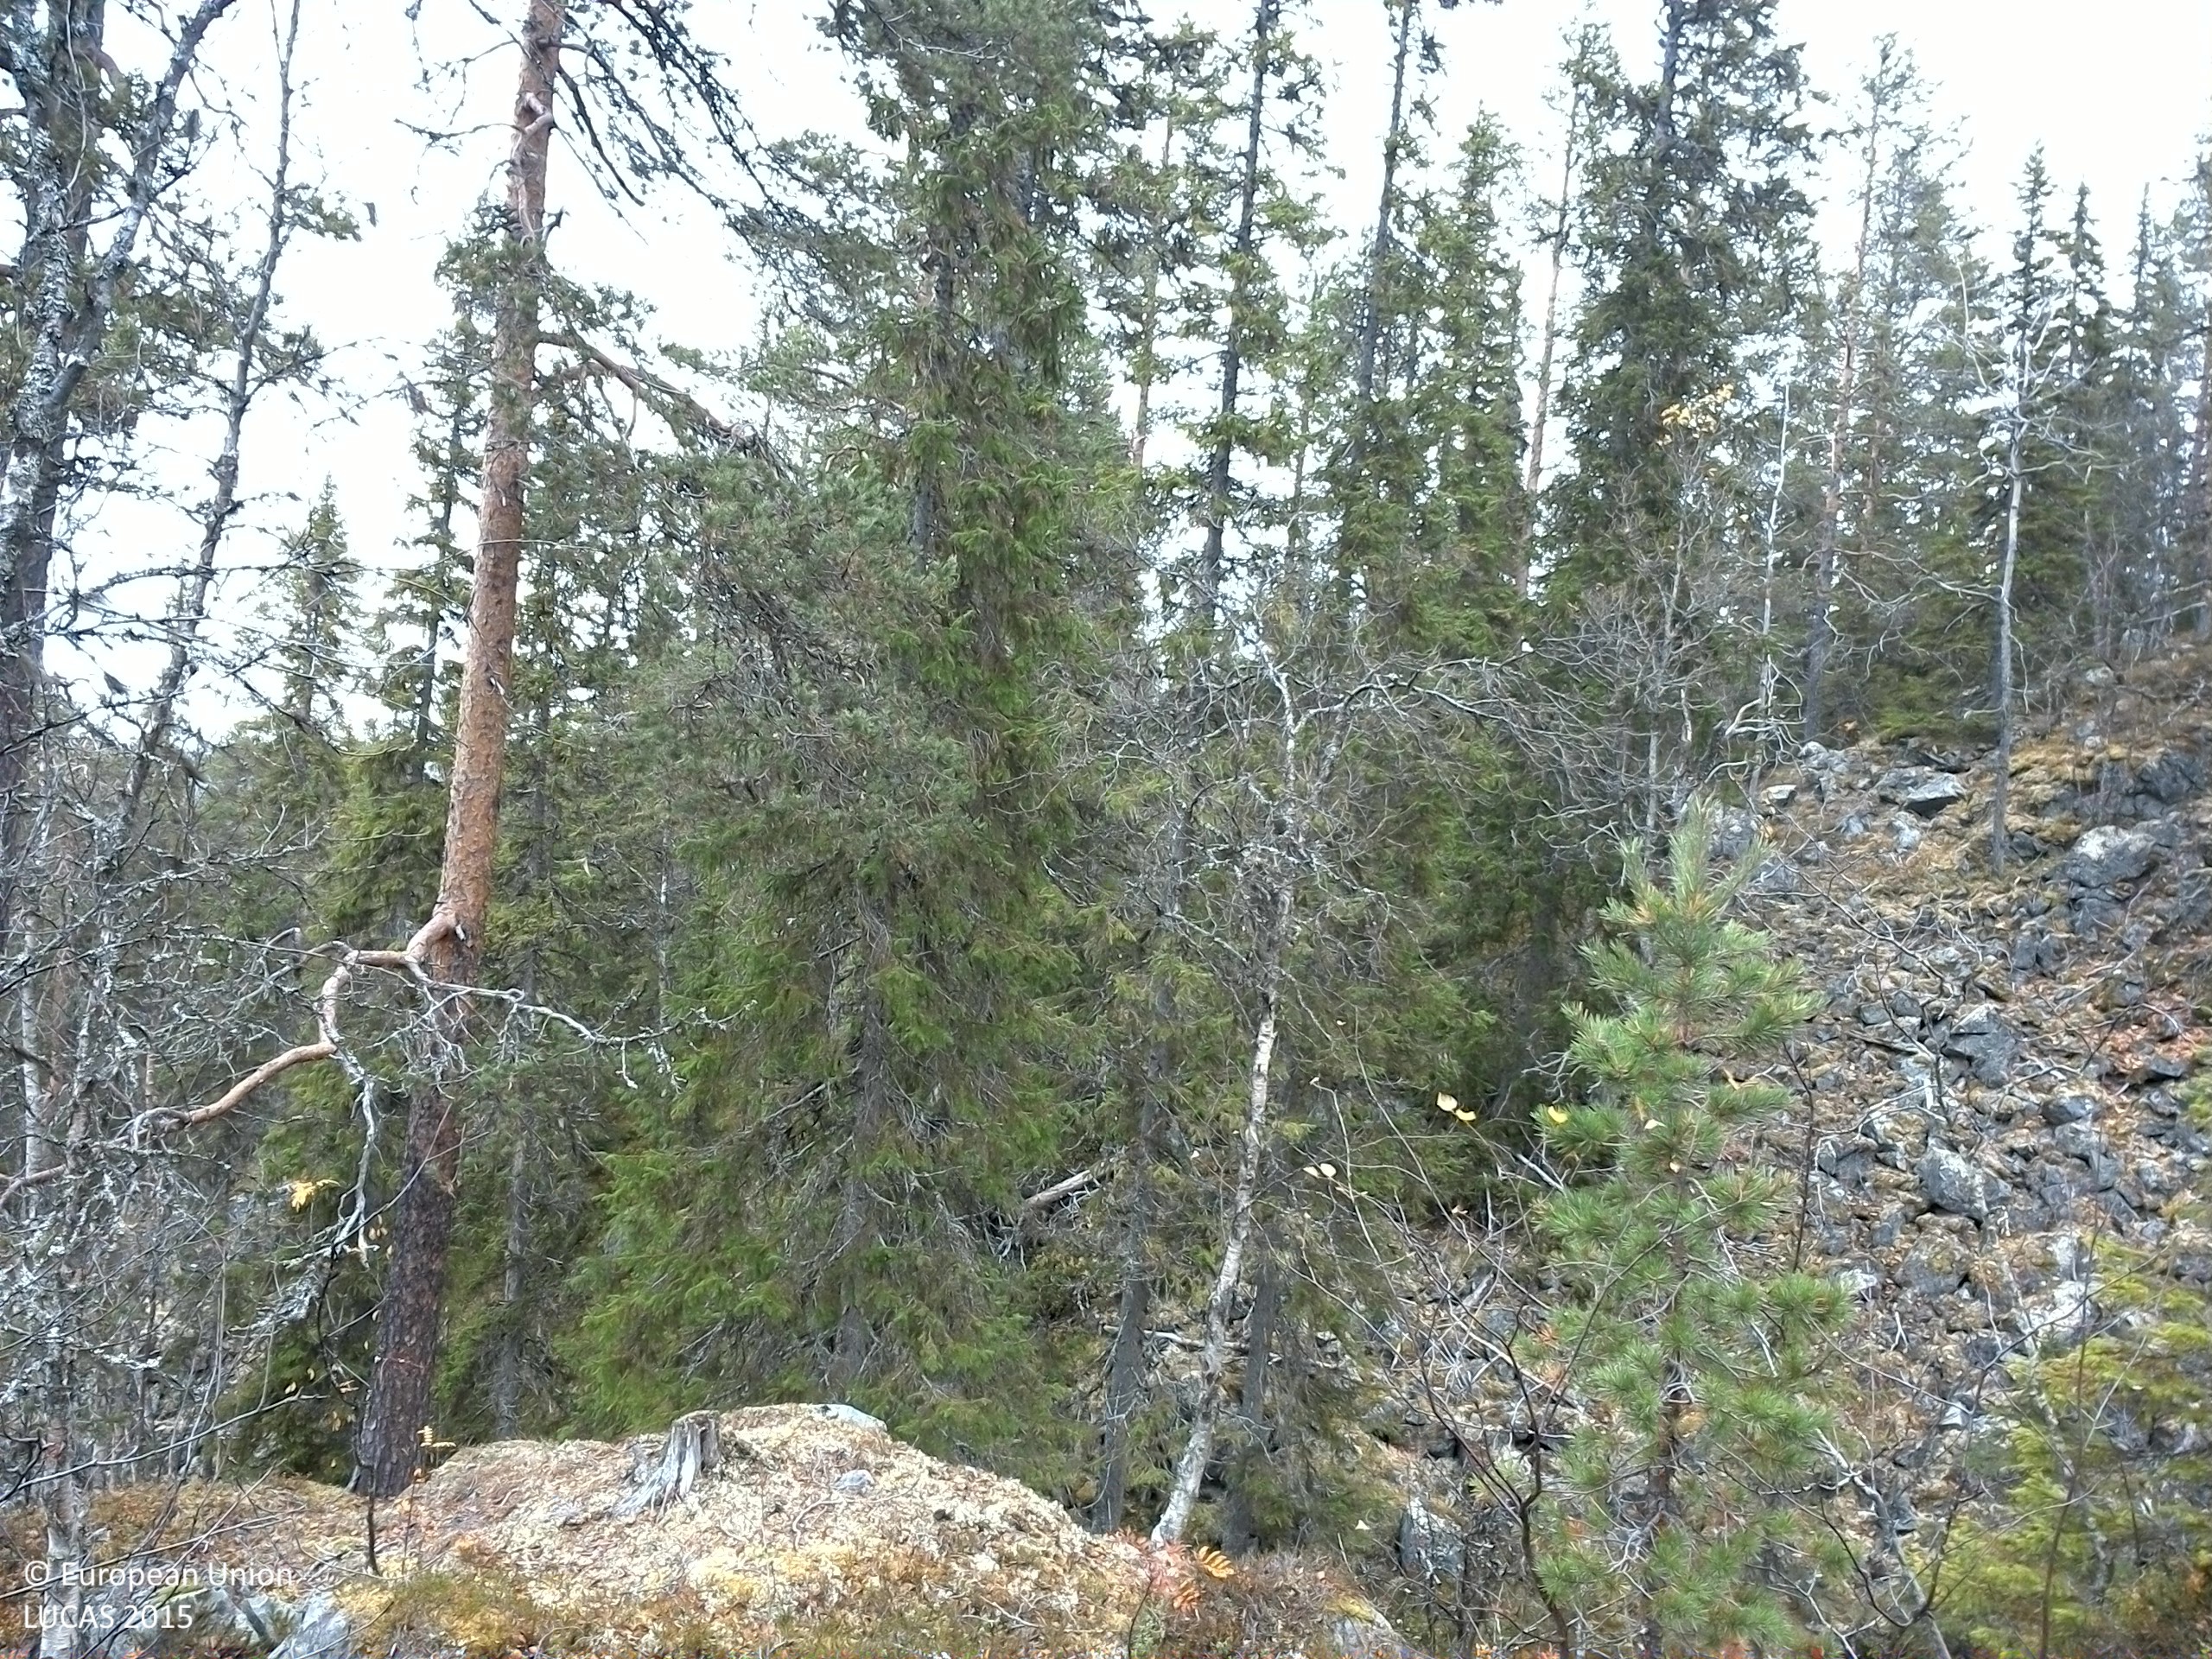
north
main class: Woodland
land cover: Other mixed woodland
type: boreal forest
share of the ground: 25 - 50 %
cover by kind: shrubs 30 %, coniferous forest trees 25 %, consolidated bare surface 20 %, lichens and mosses 15 %, broadleaved forest trees 10 %
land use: Forestry
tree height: > 5 m
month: October
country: SE
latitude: 64.4194
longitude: 15.2644
